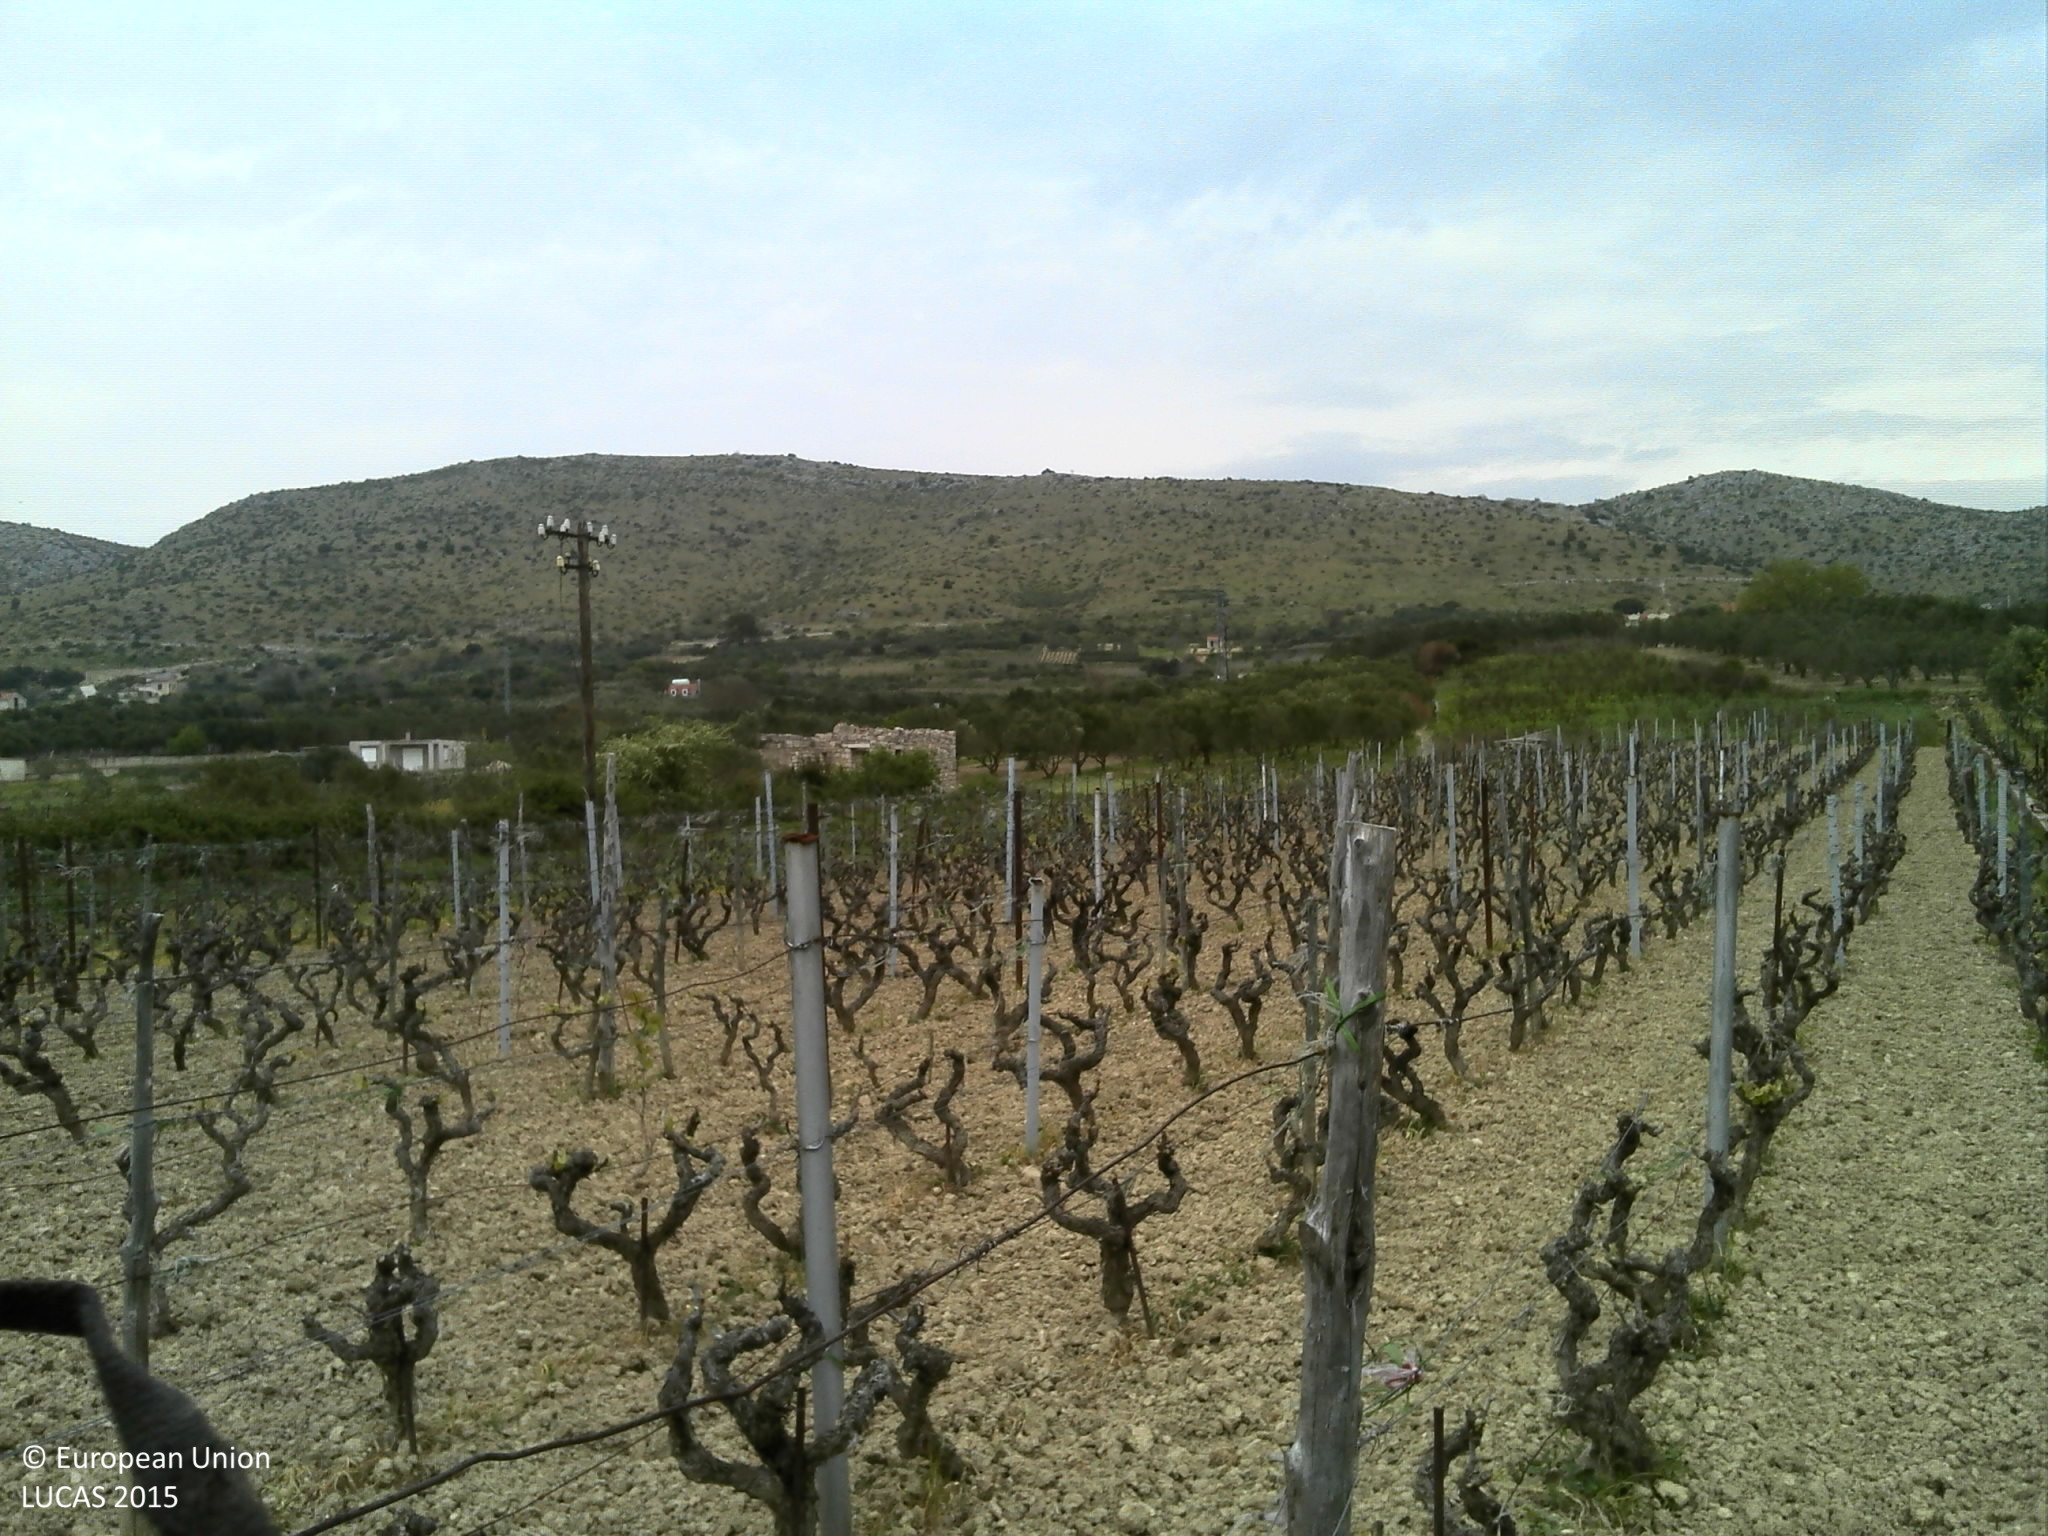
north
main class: Cropland
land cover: Vineyards
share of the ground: > 75 %
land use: Agriculture (excluding fallow land and kitchen gardens)
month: April
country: HR
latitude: 43.6910
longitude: 15.9586
